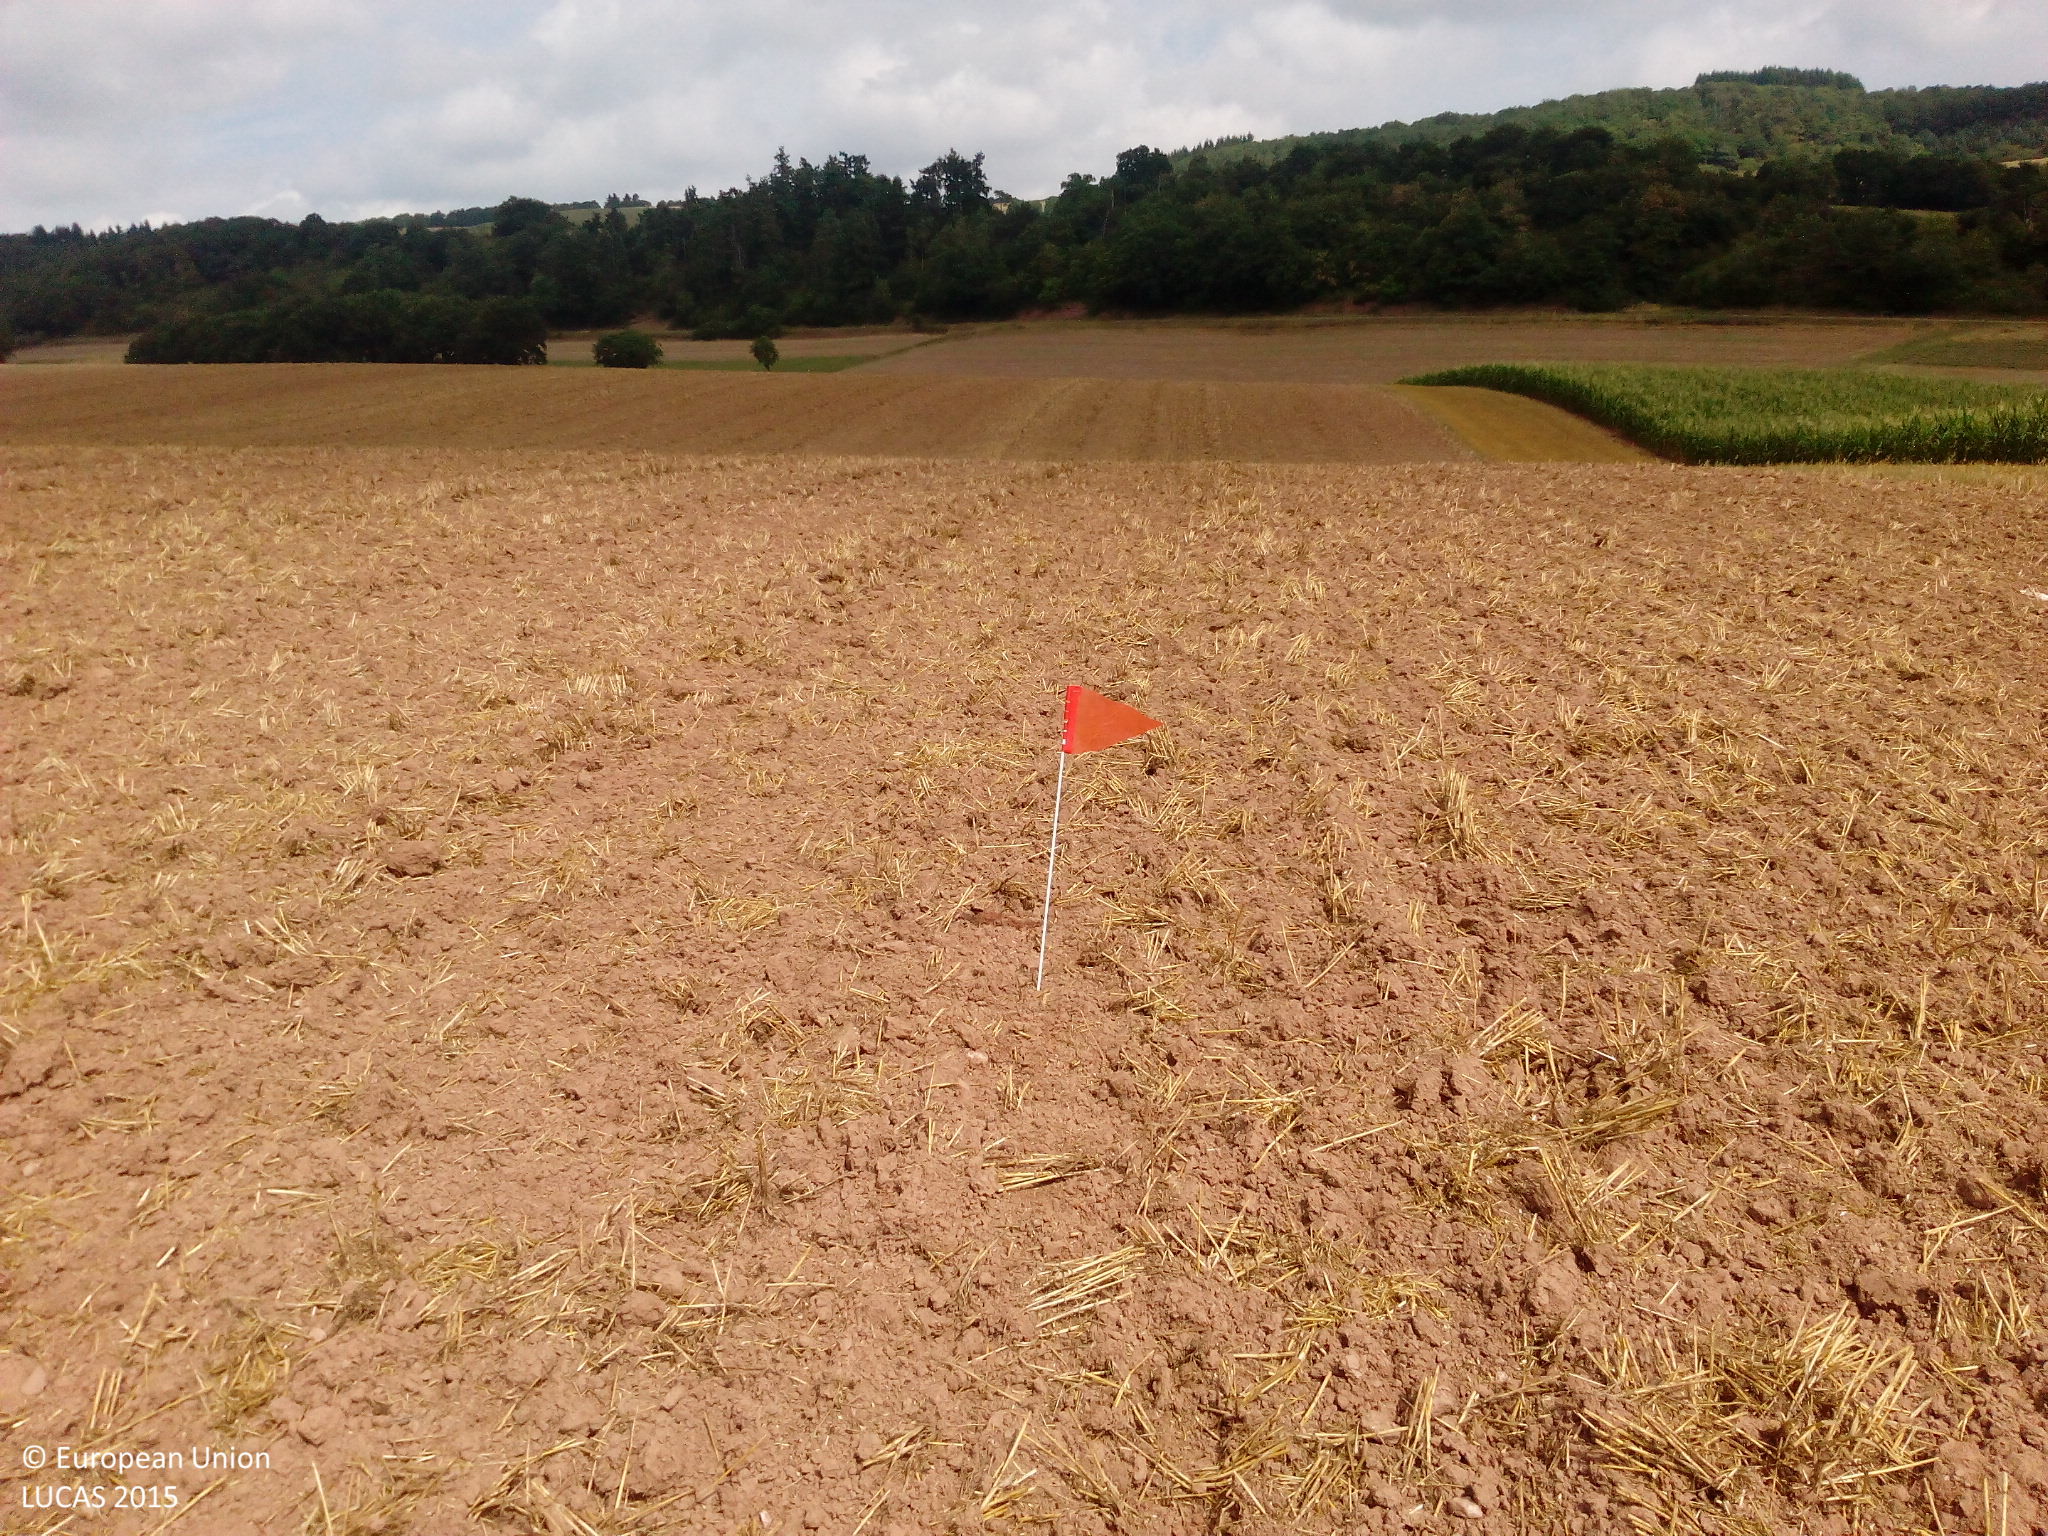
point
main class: Cropland
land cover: Common wheat
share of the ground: < 10 %
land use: Agriculture (excluding fallow land and kitchen gardens)
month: August
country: DE
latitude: 49.7440
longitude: 7.5441
